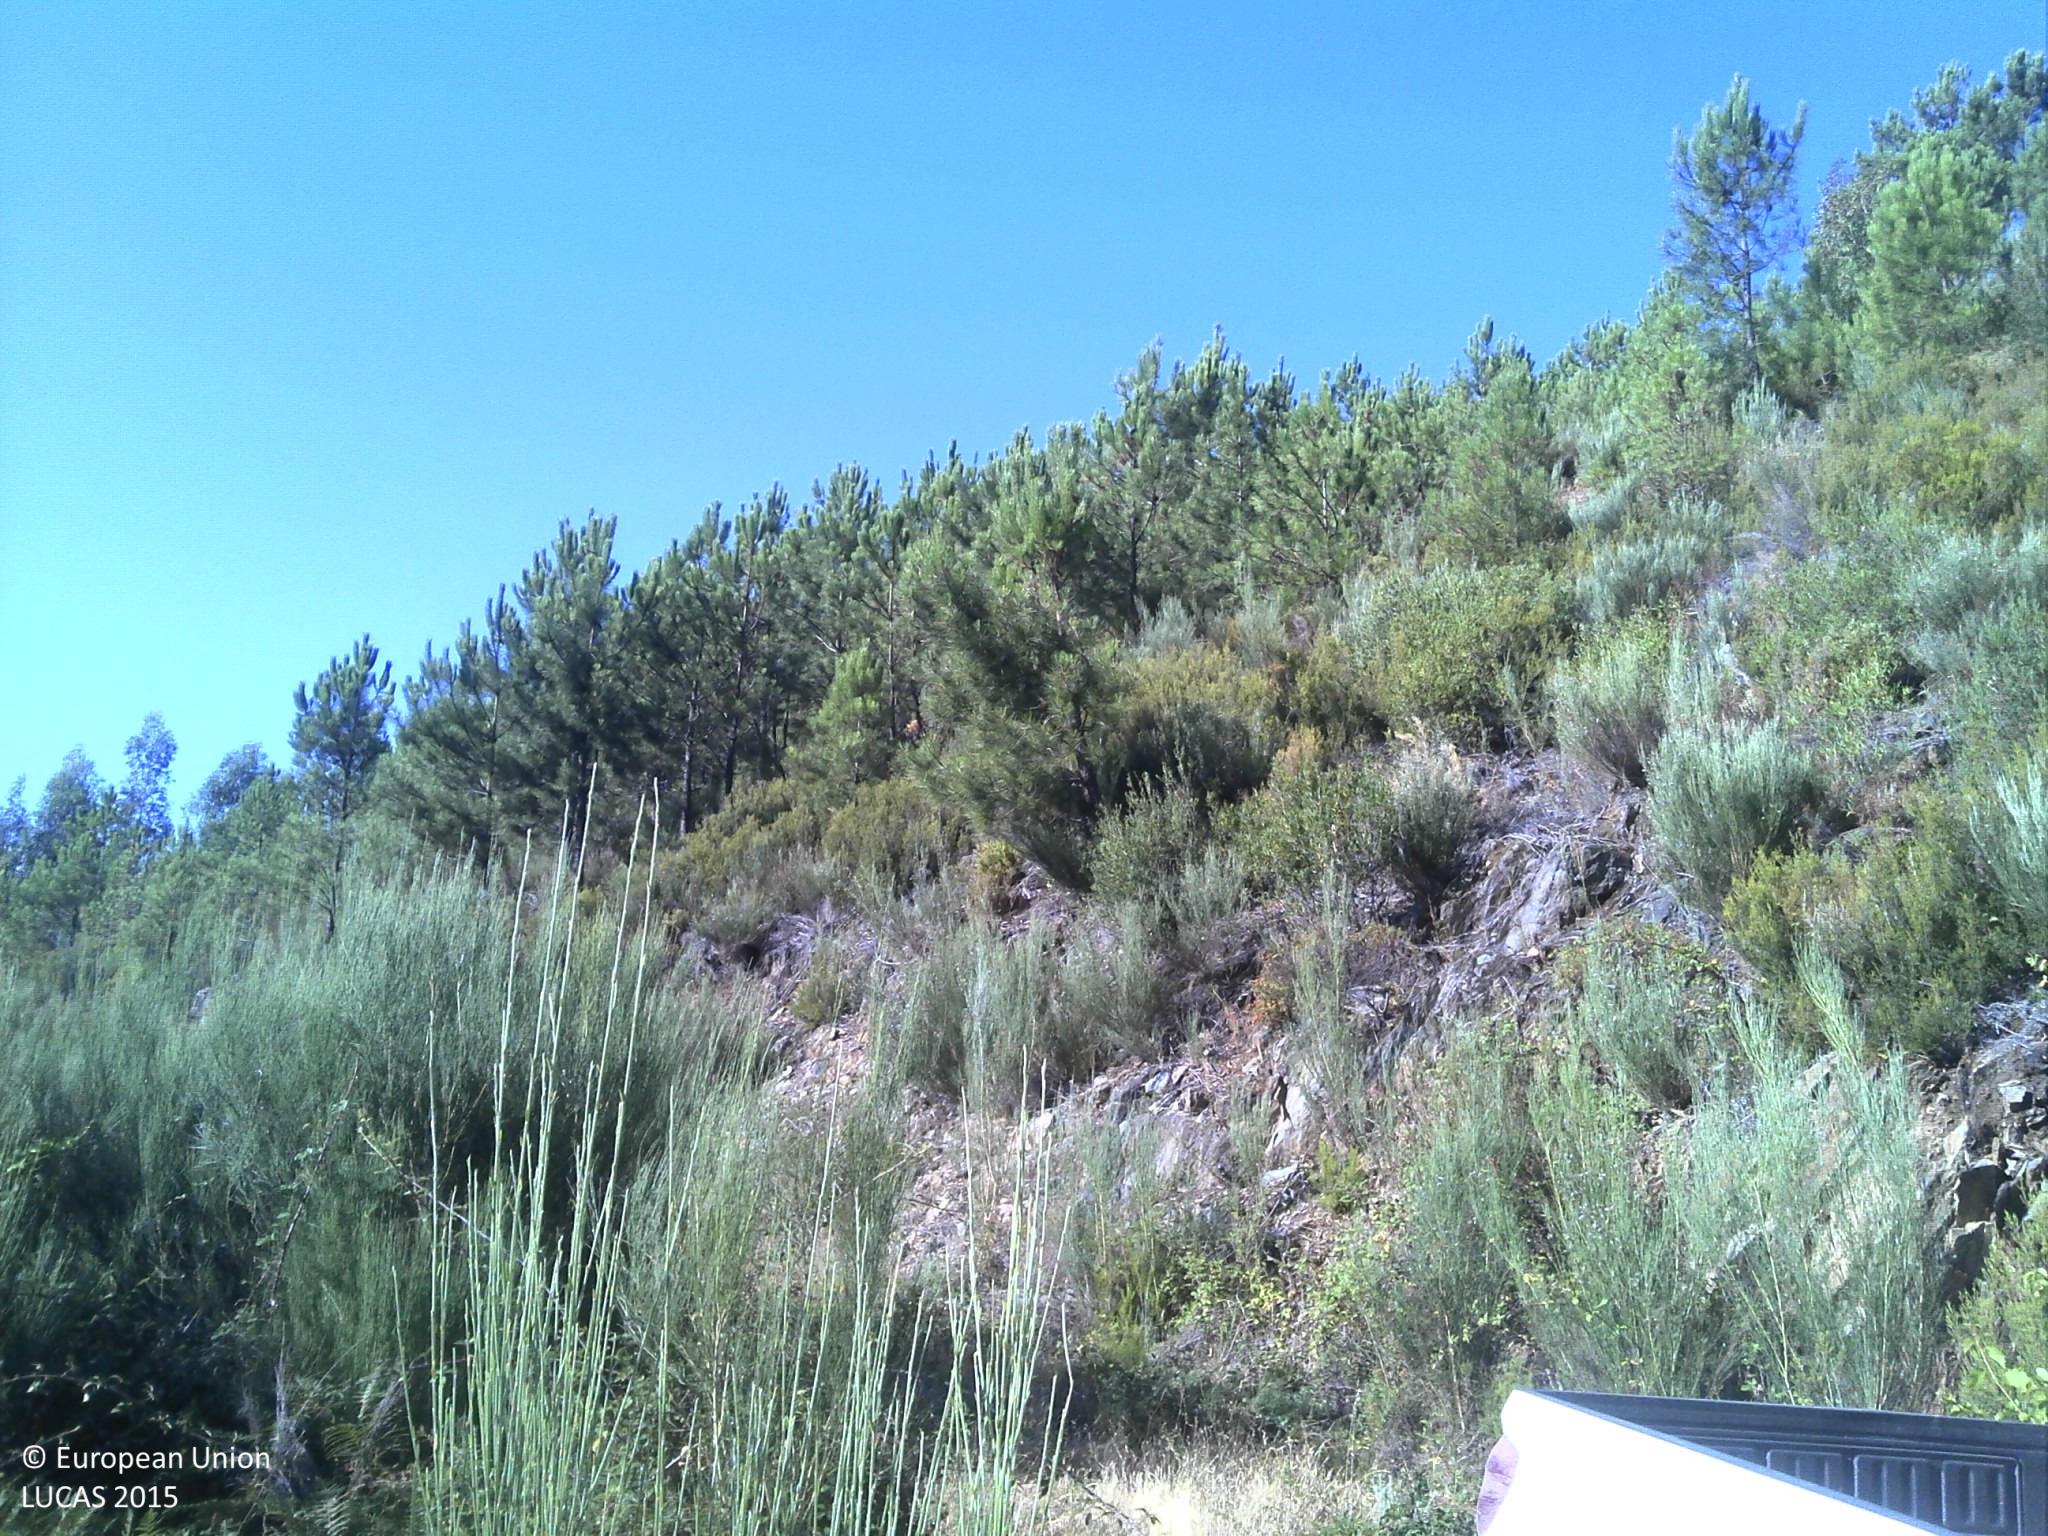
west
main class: Shrubland
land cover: Shrubland with sparse tree cover
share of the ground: 50 - 75 %
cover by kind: shrubs 70 %, unconsolidated bare surface 20 %, coniferous forest trees 5 %, consolidated bare surface 5 %
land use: Abandoned areas
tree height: > 5 m
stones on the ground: 10 - 25 %
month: July
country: PT
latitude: 40.2389
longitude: -7.6597
